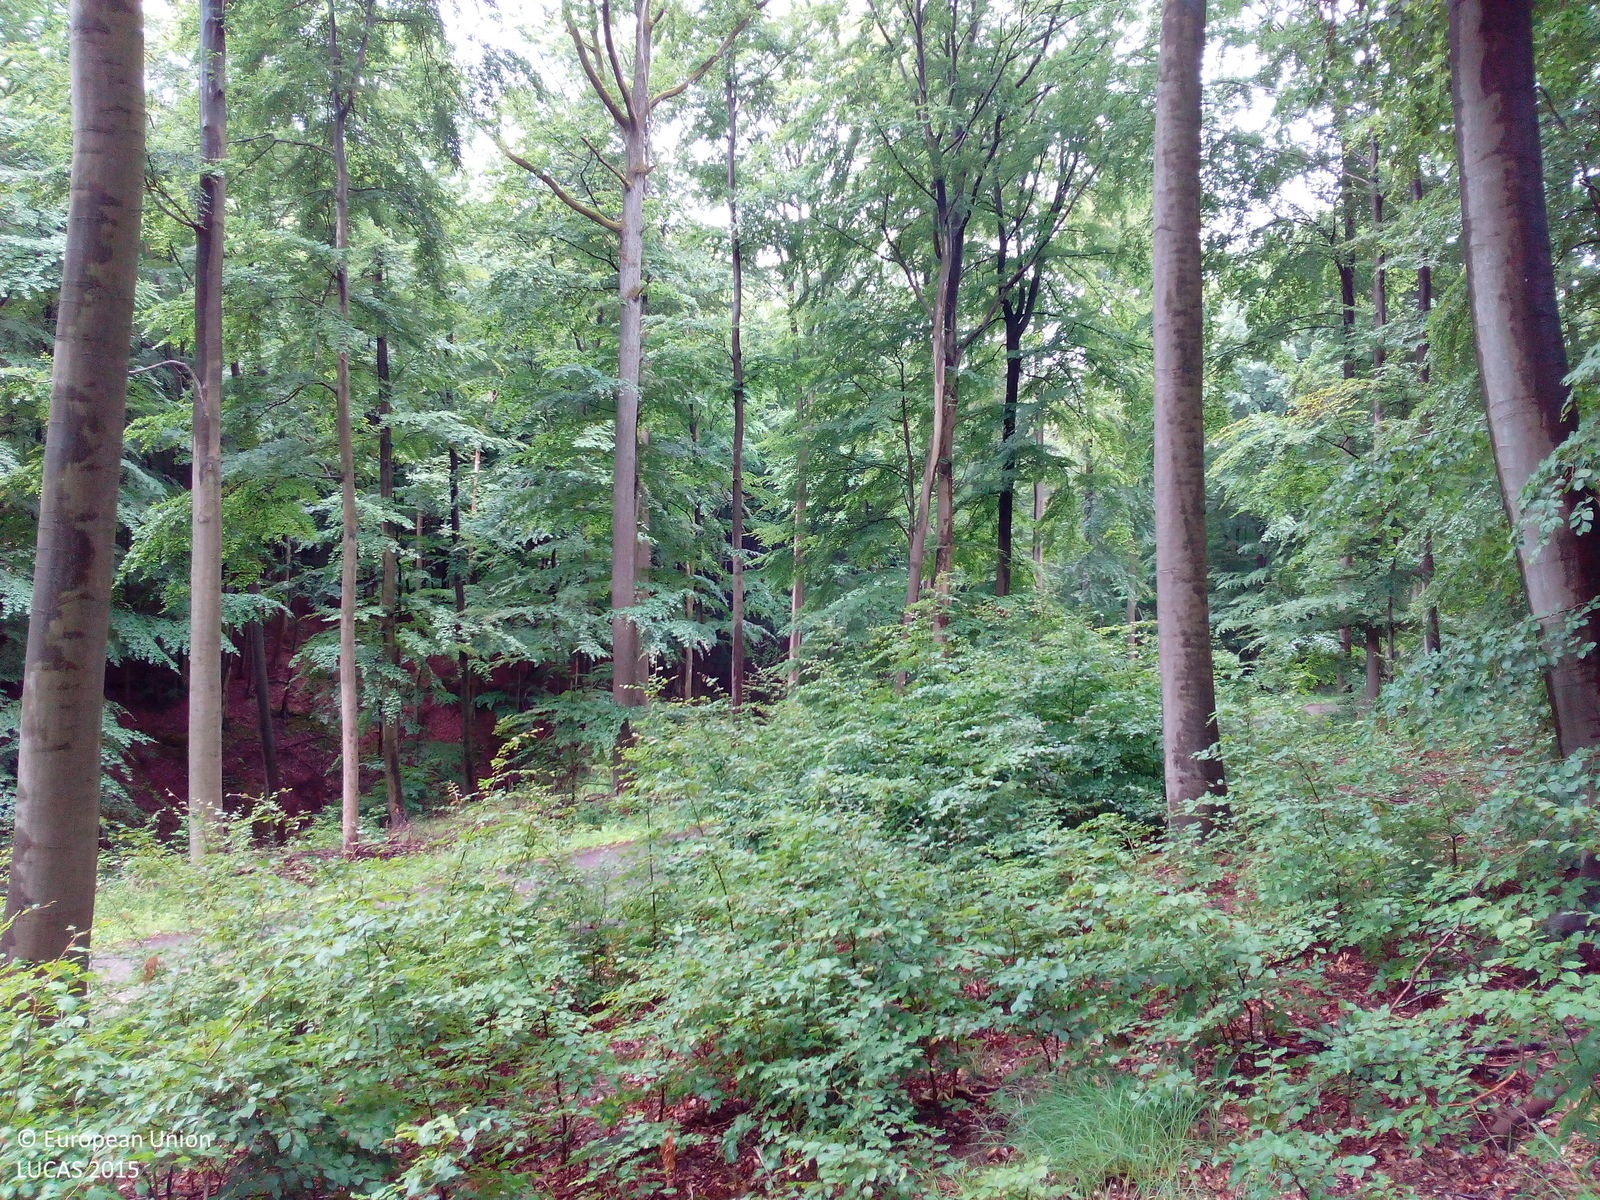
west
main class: Woodland
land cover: Broadleaved woodland
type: beech forest
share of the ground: > 75 %
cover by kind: broadleaved forest trees 90 %, herbaceous plants 10 %
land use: Forestry
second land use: Amenities, museums, leisure
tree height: > 5 m
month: June
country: DE
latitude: 51.9640
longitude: 9.8691
